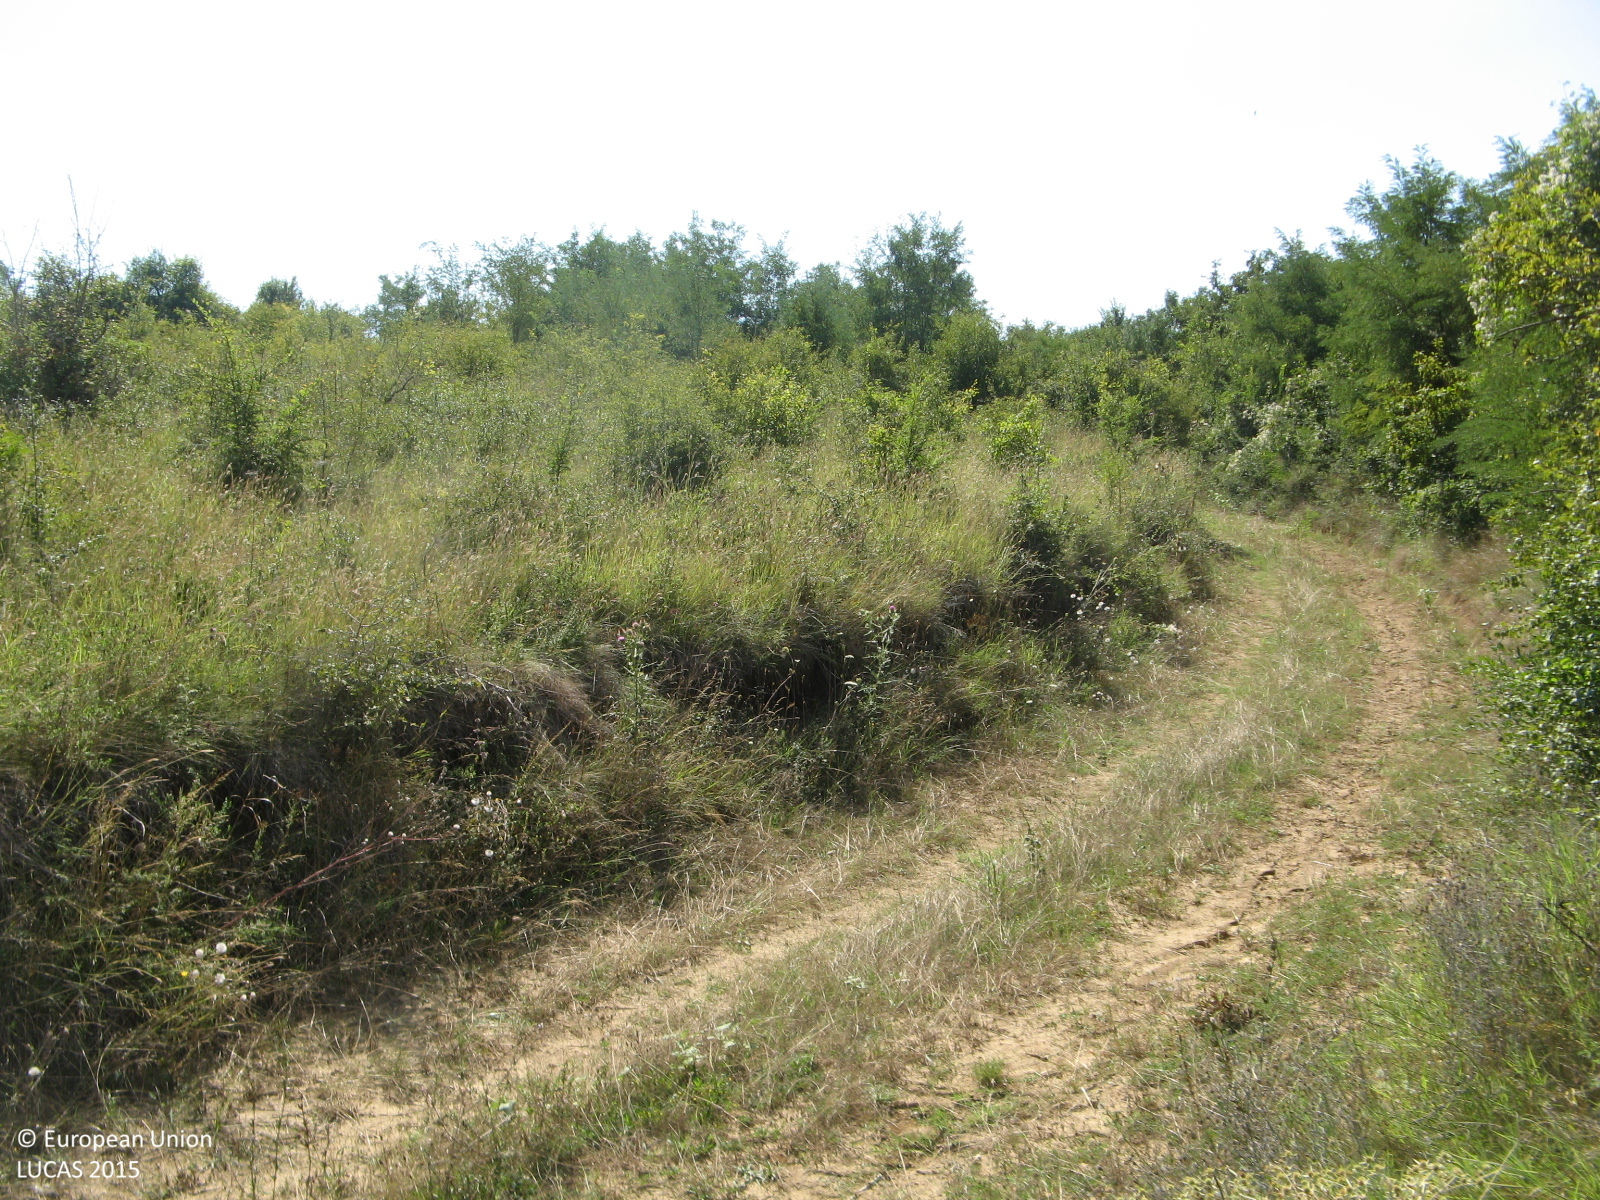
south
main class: Shrubland
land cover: Shrubland with sparse tree cover
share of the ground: > 75 %
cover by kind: shrubs 90 %, broadleaved forest trees 5 %, herbaceous plants 5 %
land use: Semi-natural and natural areas not in use
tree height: > 5 m
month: August
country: BG
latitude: 43.5069
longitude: 25.8599
